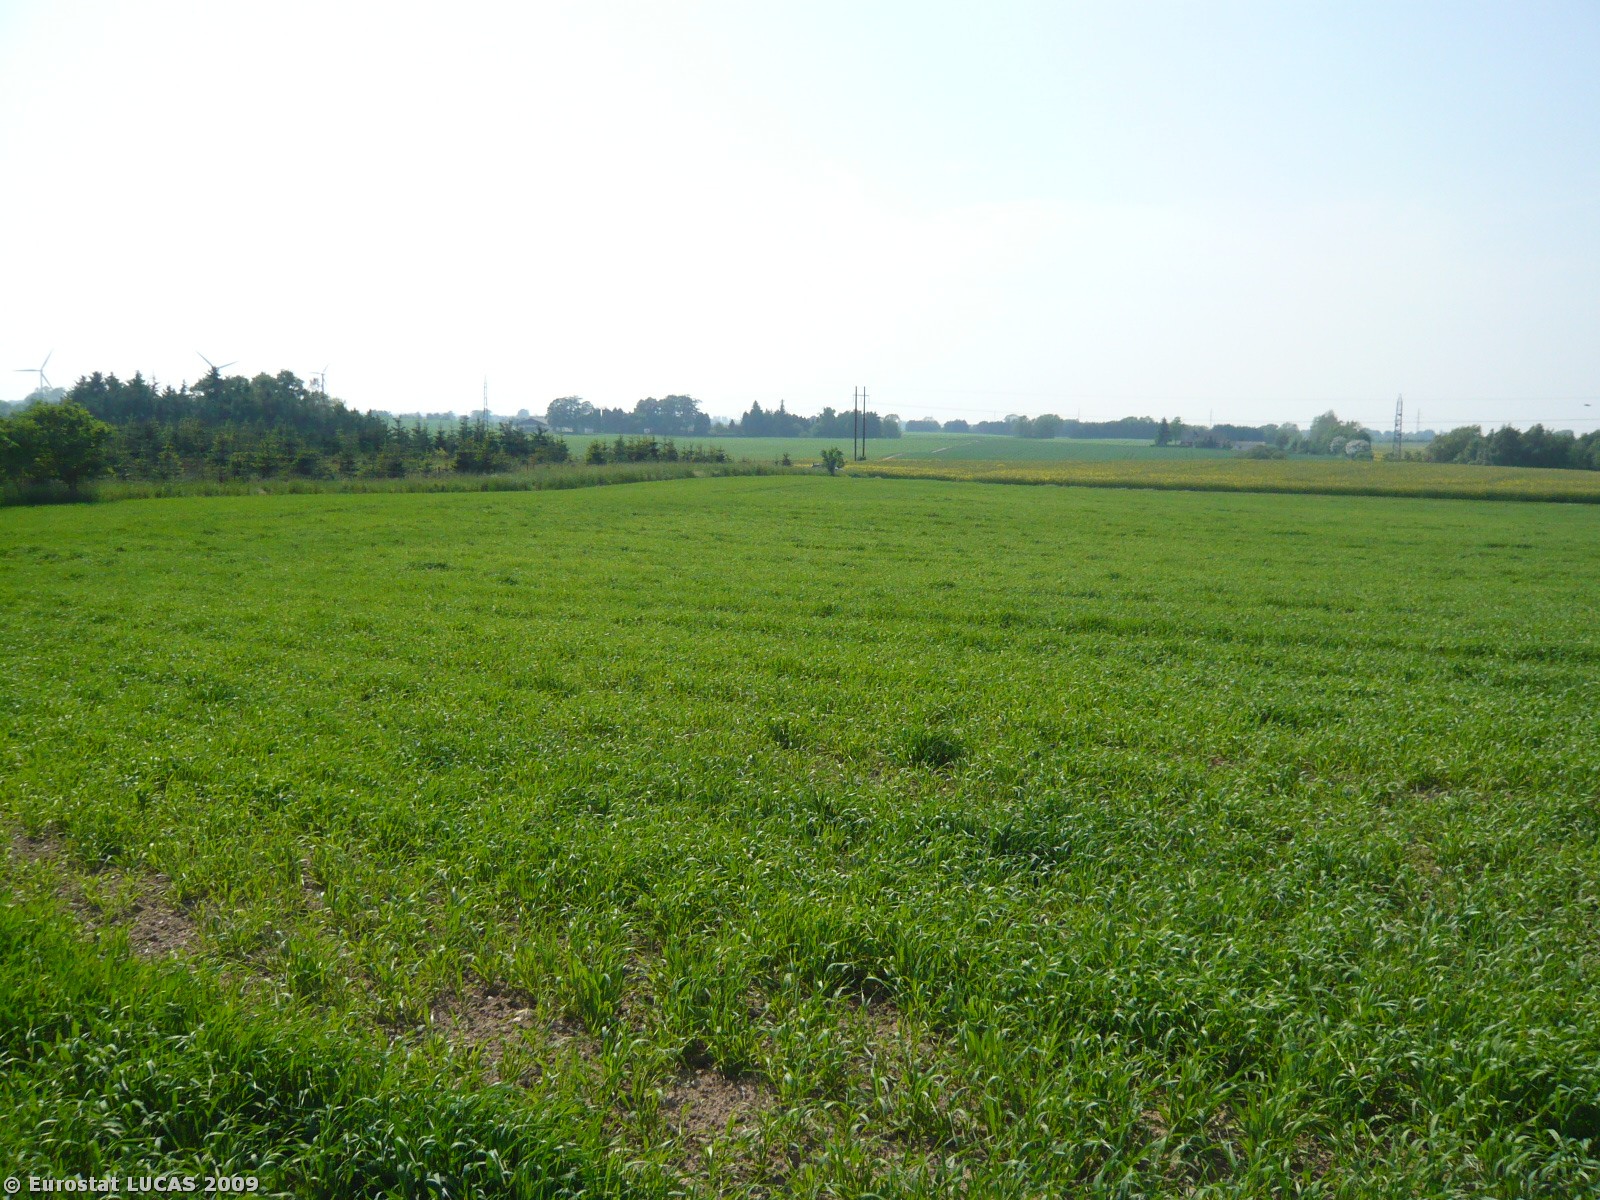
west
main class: Cropland
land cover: Barley
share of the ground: > 75 %
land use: Agriculture (excluding fallow land and kitchen gardens)
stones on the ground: < 10 %
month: May
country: DK
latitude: 55.2414
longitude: 11.7130
